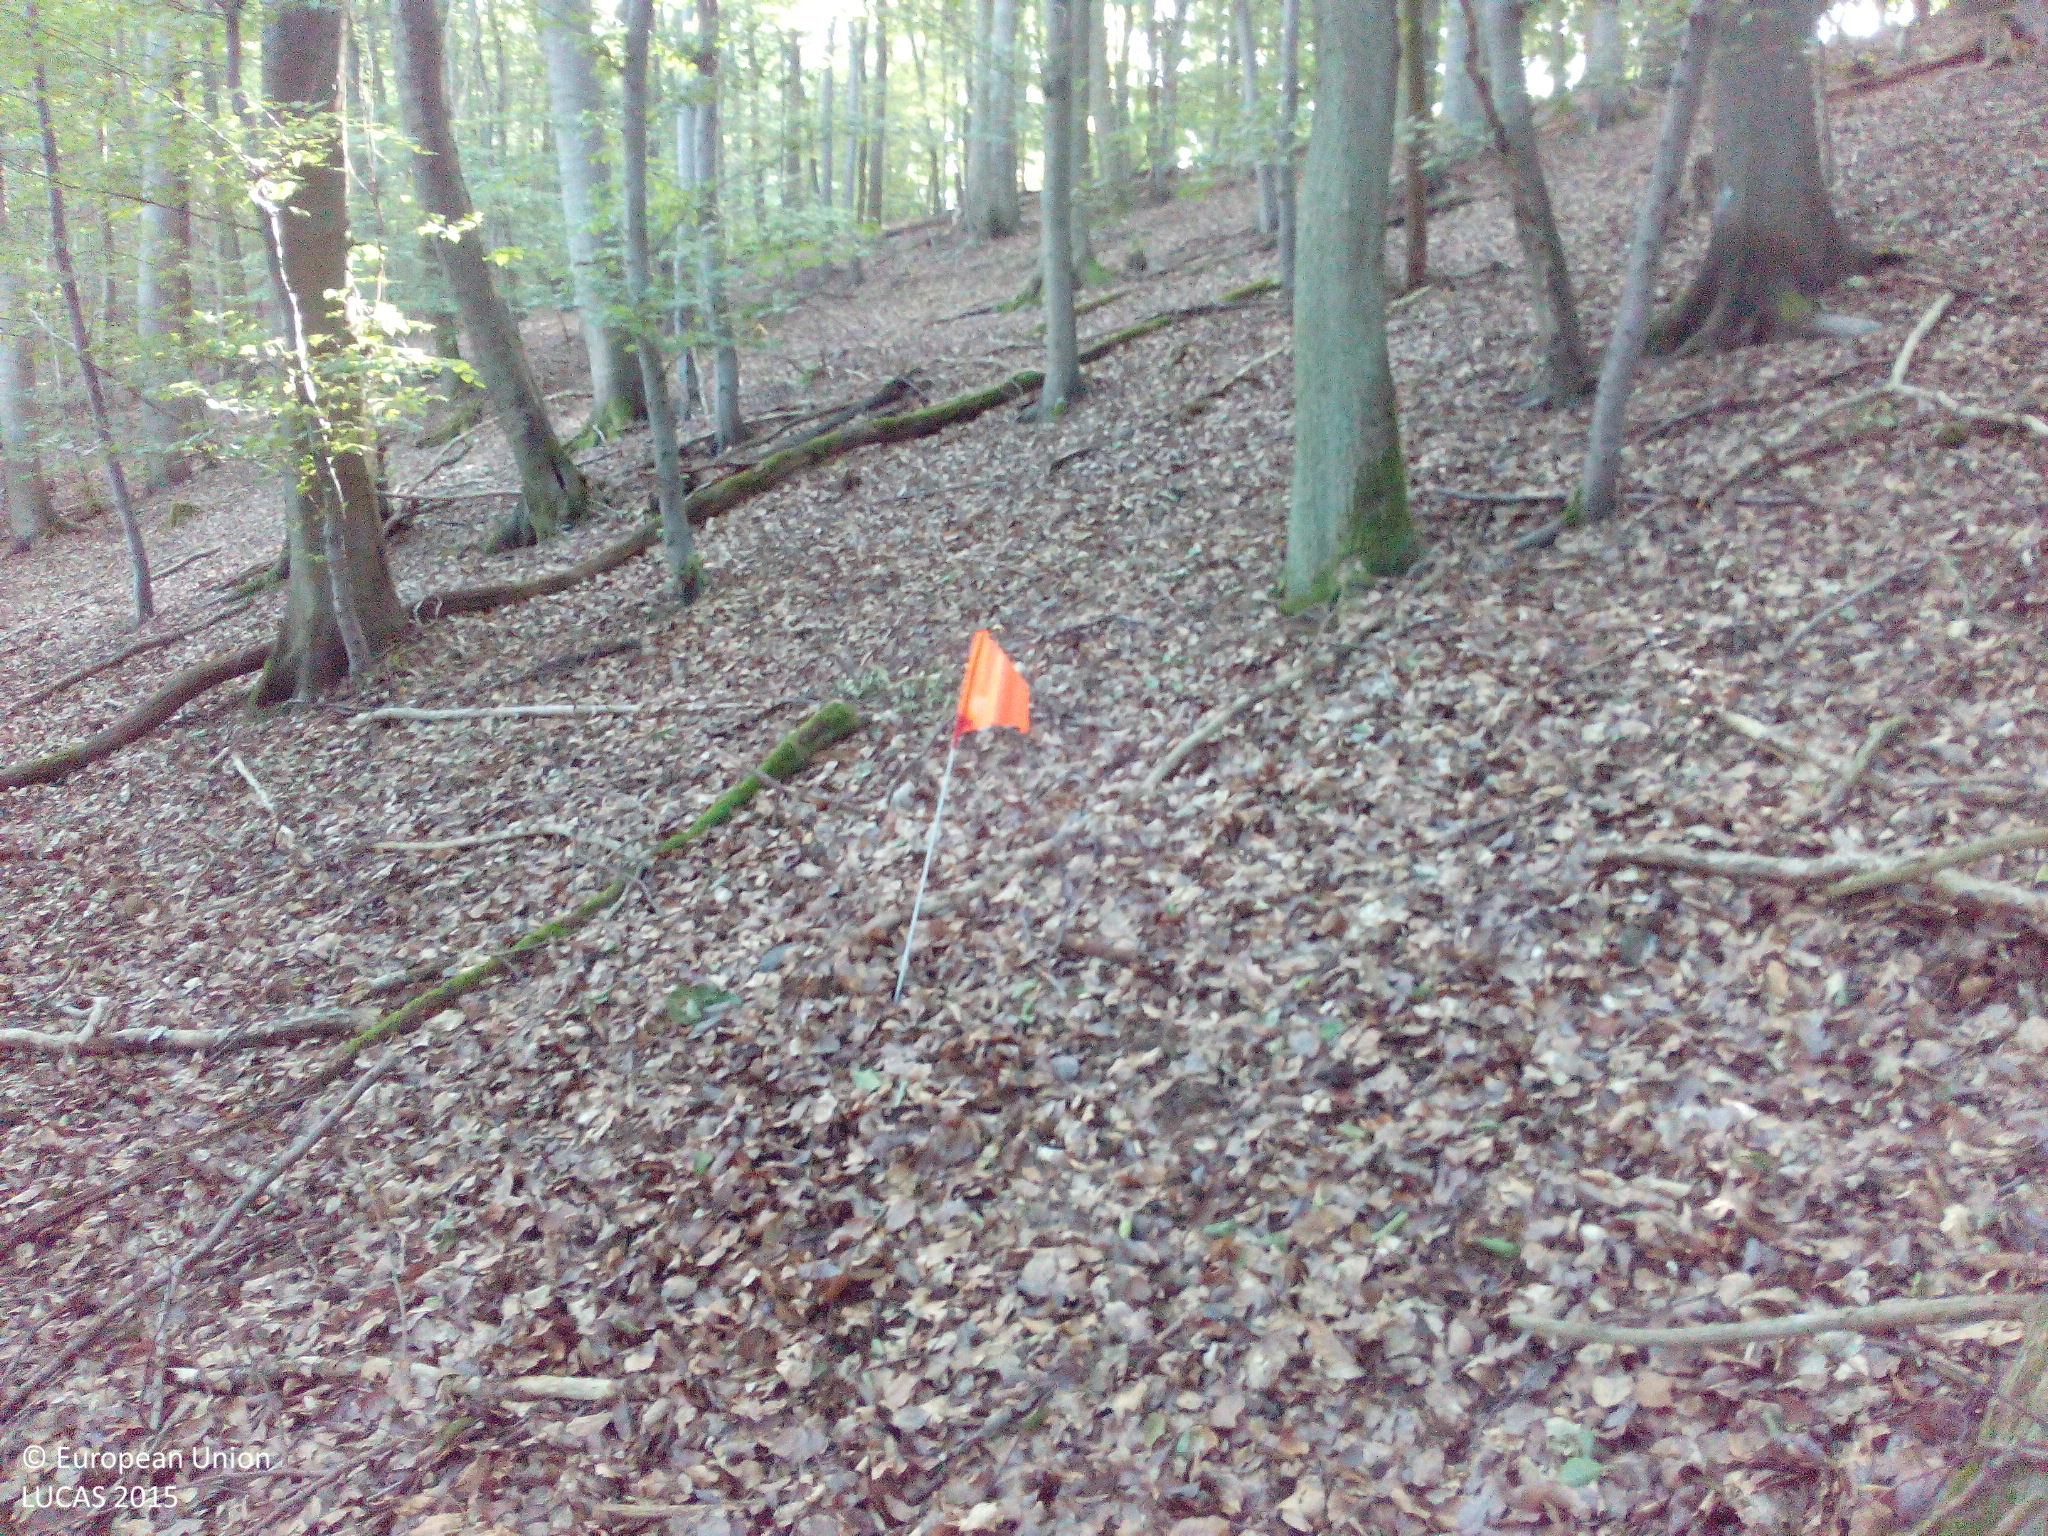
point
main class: Woodland
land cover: Broadleaved woodland
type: beech forest
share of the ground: > 75 %
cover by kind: broadleaved forest trees 90 %, unconsolidated bare surface 10 %
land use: Forestry
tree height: > 5 m
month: July
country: DE
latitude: 49.8153
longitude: 7.5127
